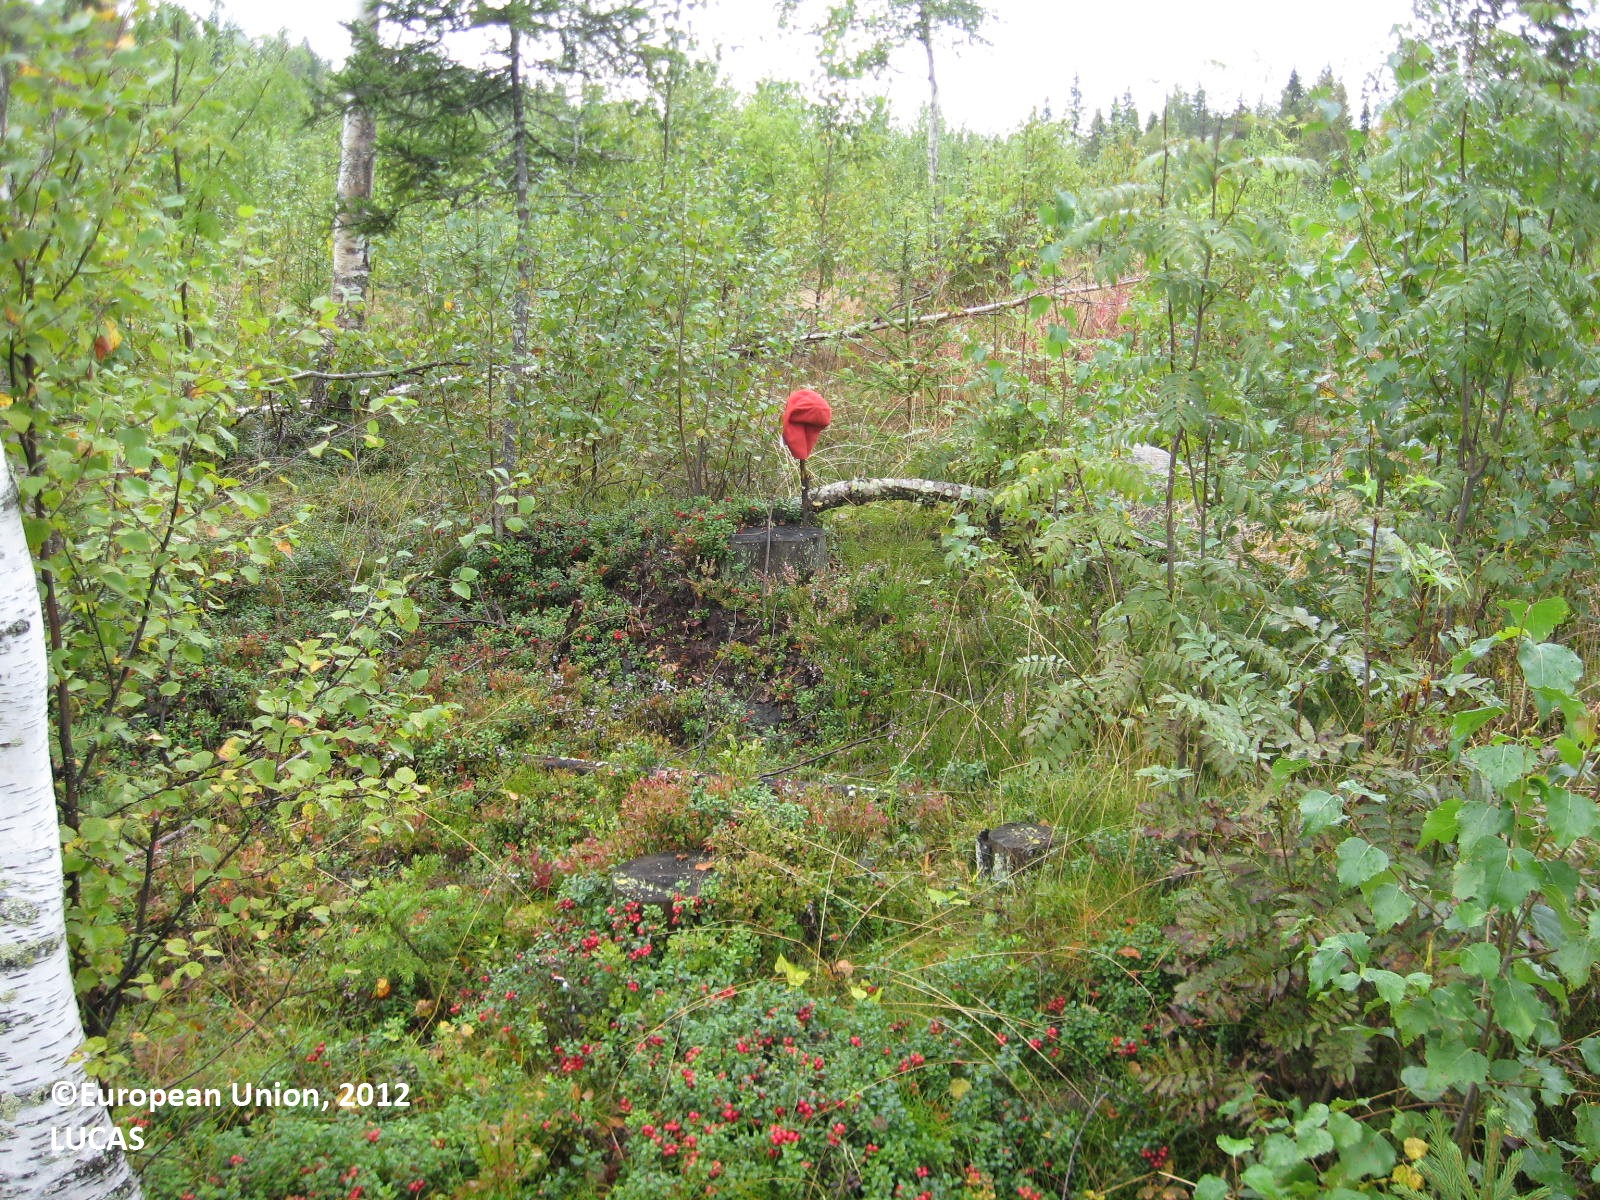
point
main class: Woodland
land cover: Other mixed woodland
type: boreal forest
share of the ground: > 75 %
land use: Forestry
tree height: < 5 m
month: August
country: FI
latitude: 63.5769
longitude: 29.3763
